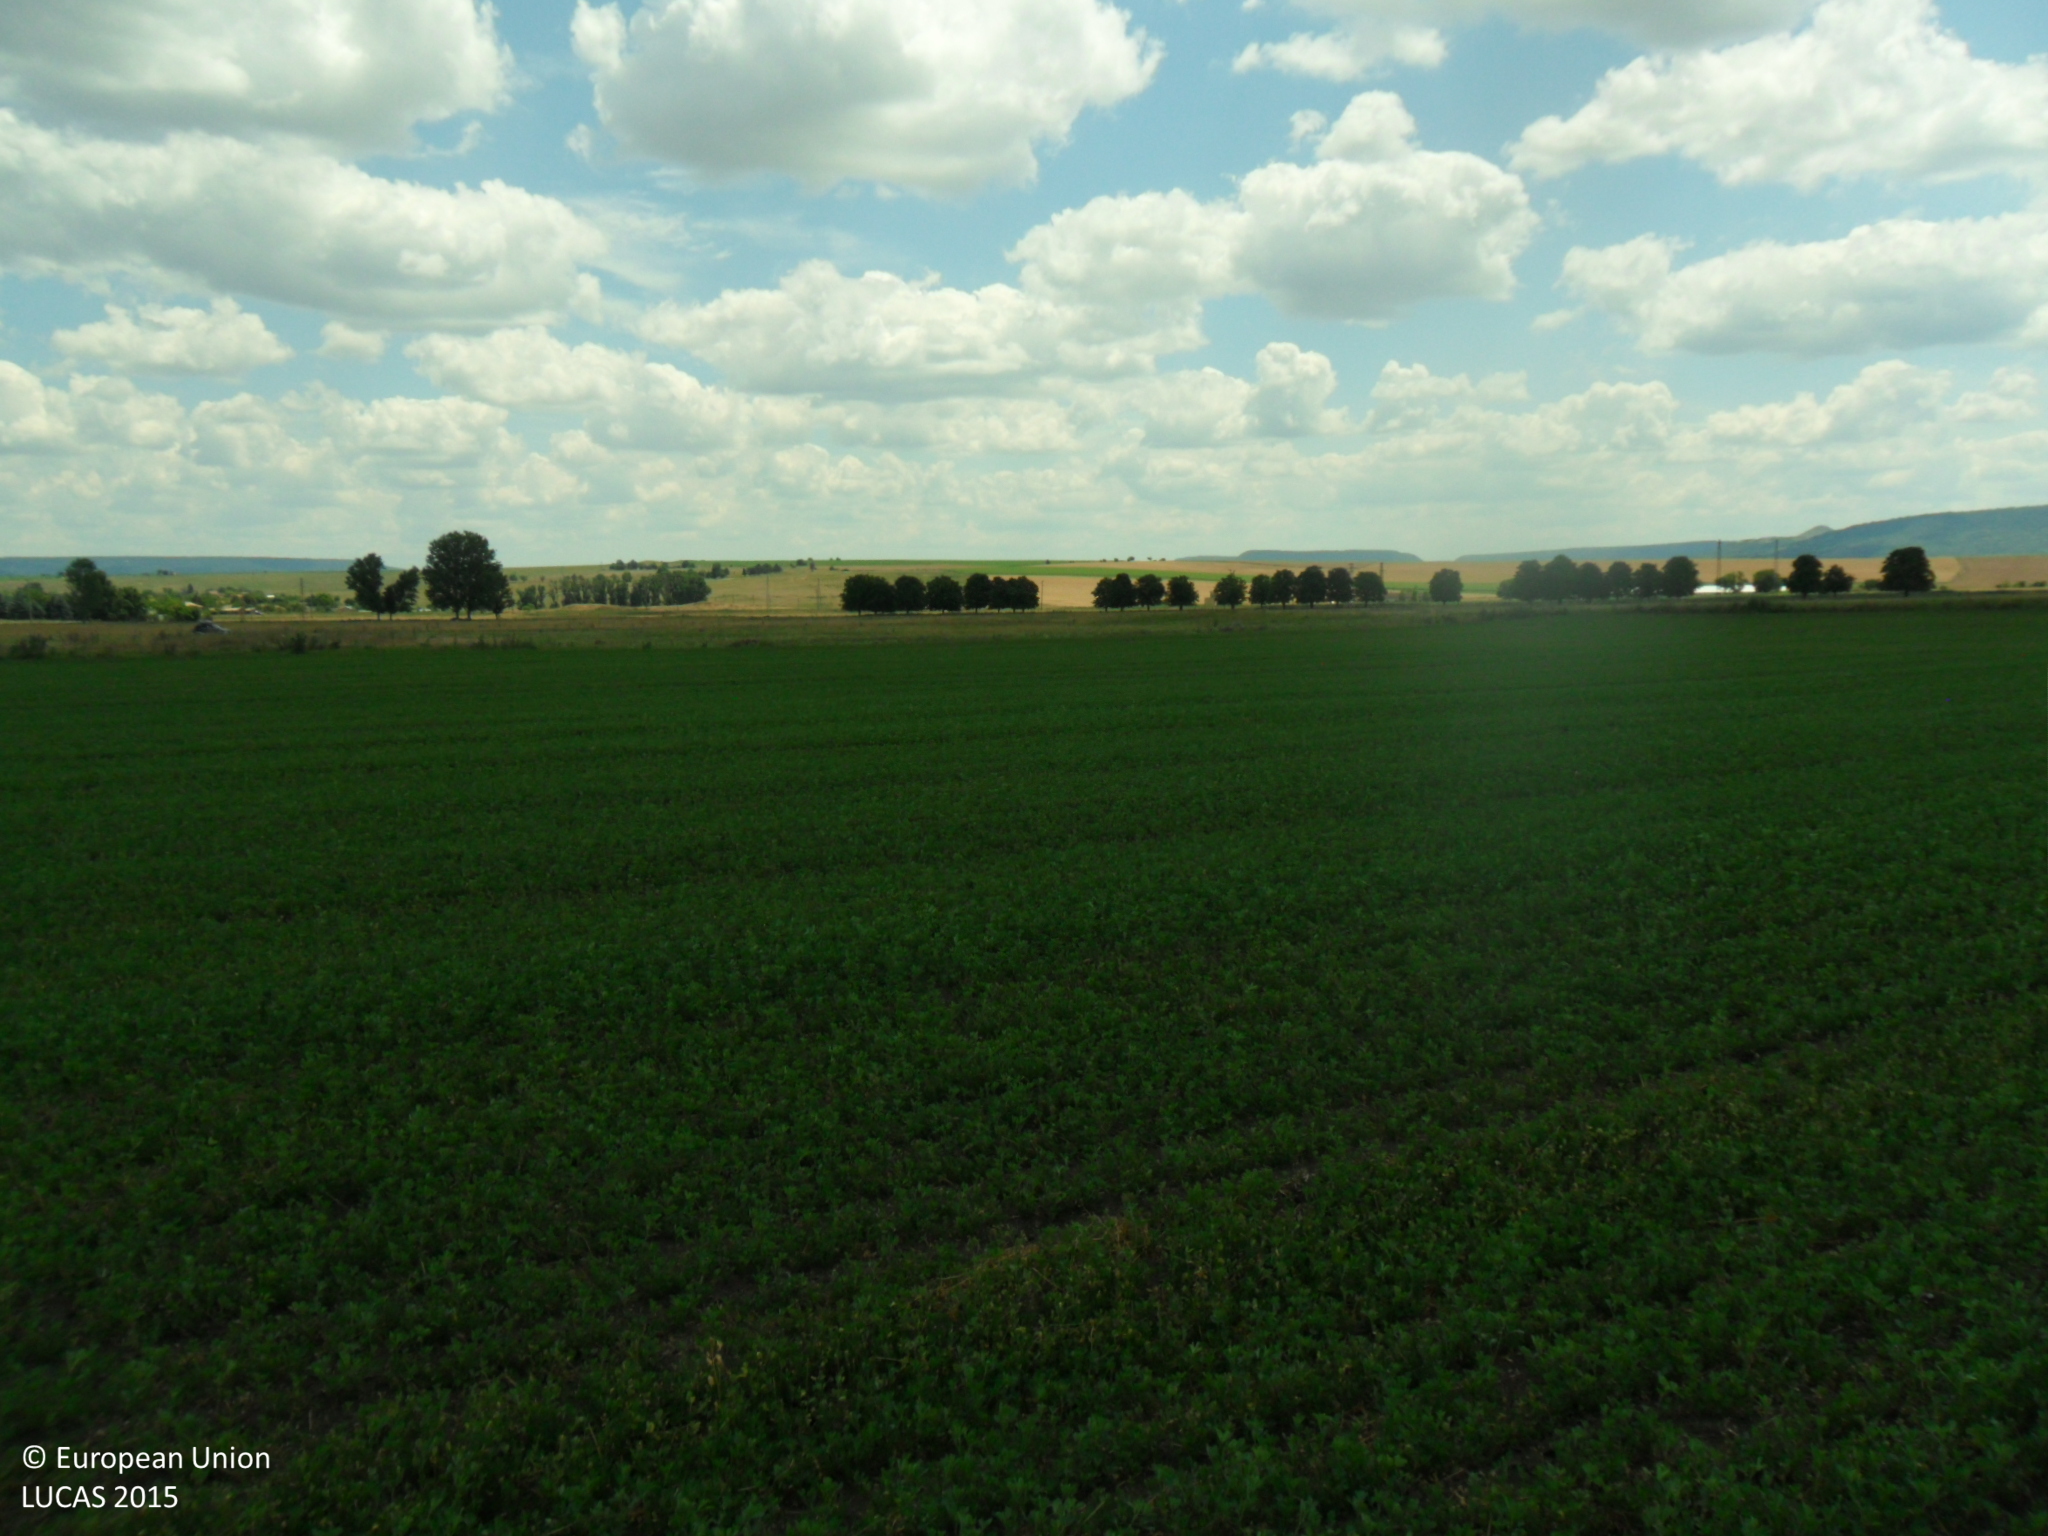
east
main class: Cropland
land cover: Lucerne
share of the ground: > 75 %
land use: Agriculture (excluding fallow land and kitchen gardens)
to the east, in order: Lucerne; Grassland without tree/shrub cover; Tracks; Grassland without tree/shrub cover; Tracks; Grassland without tree/shrub cover
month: June
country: BG
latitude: 43.3585
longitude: 27.1090
